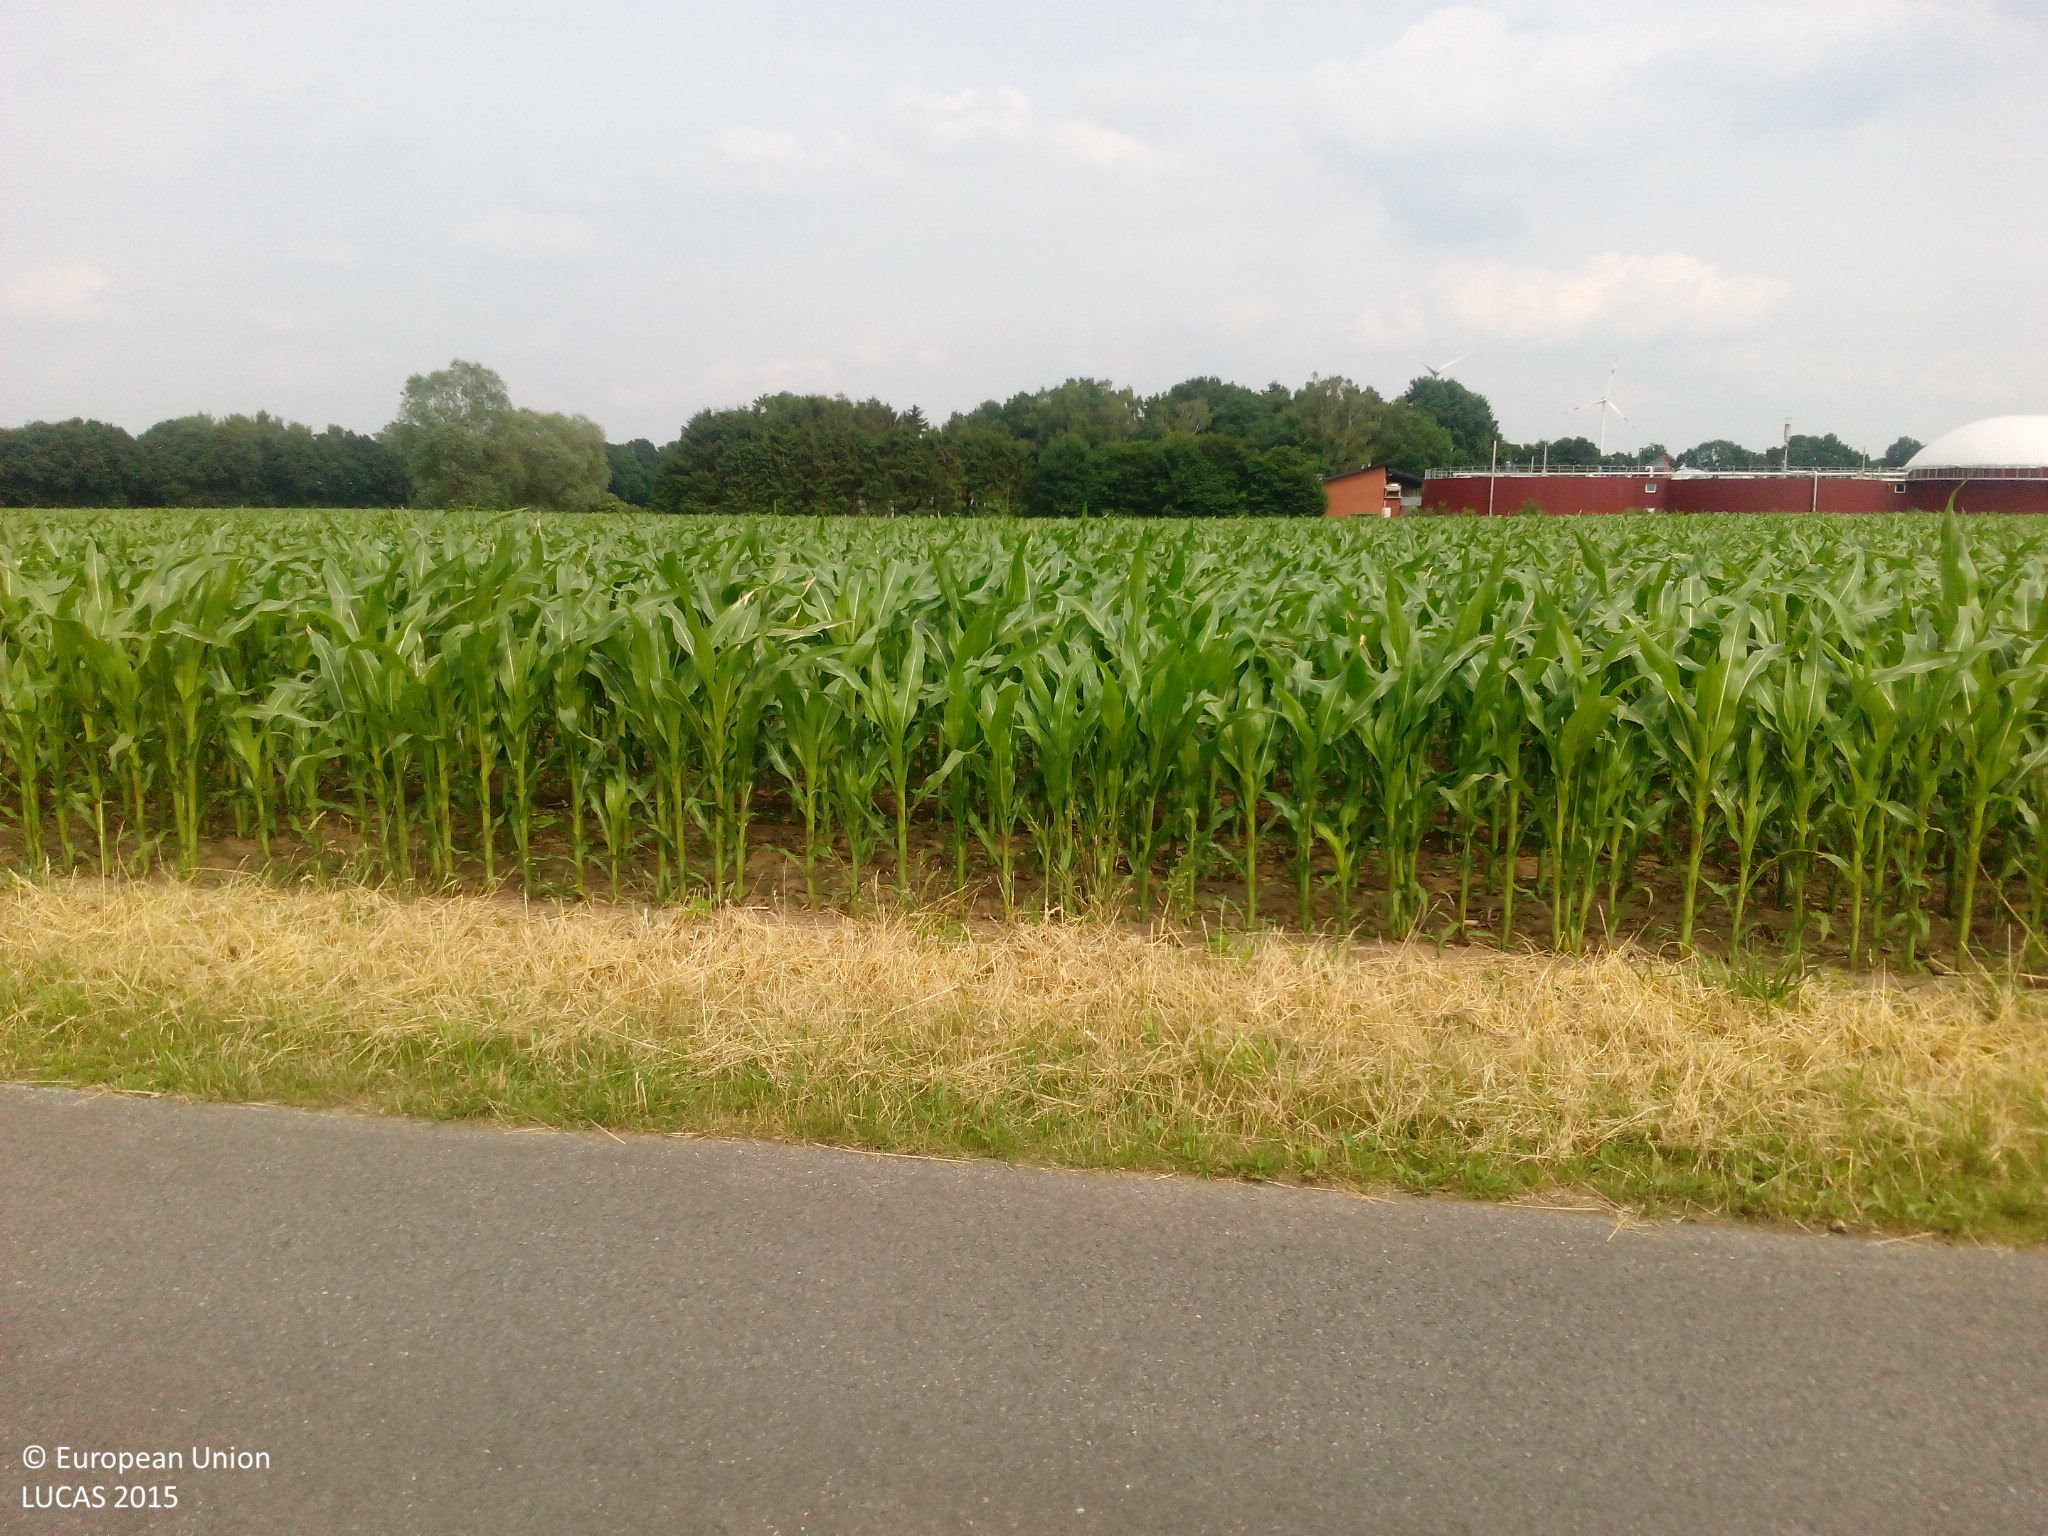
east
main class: Cropland
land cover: Maize
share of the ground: > 75 %
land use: Agriculture (excluding fallow land and kitchen gardens)
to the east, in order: Maize; Grass margins; Paved roads, cycling and walking lanes; Grass margins; Maize; Shruby margins; Grass margins; Artificial constructions in urban areas
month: June
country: DE
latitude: 51.7741
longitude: 8.4497
